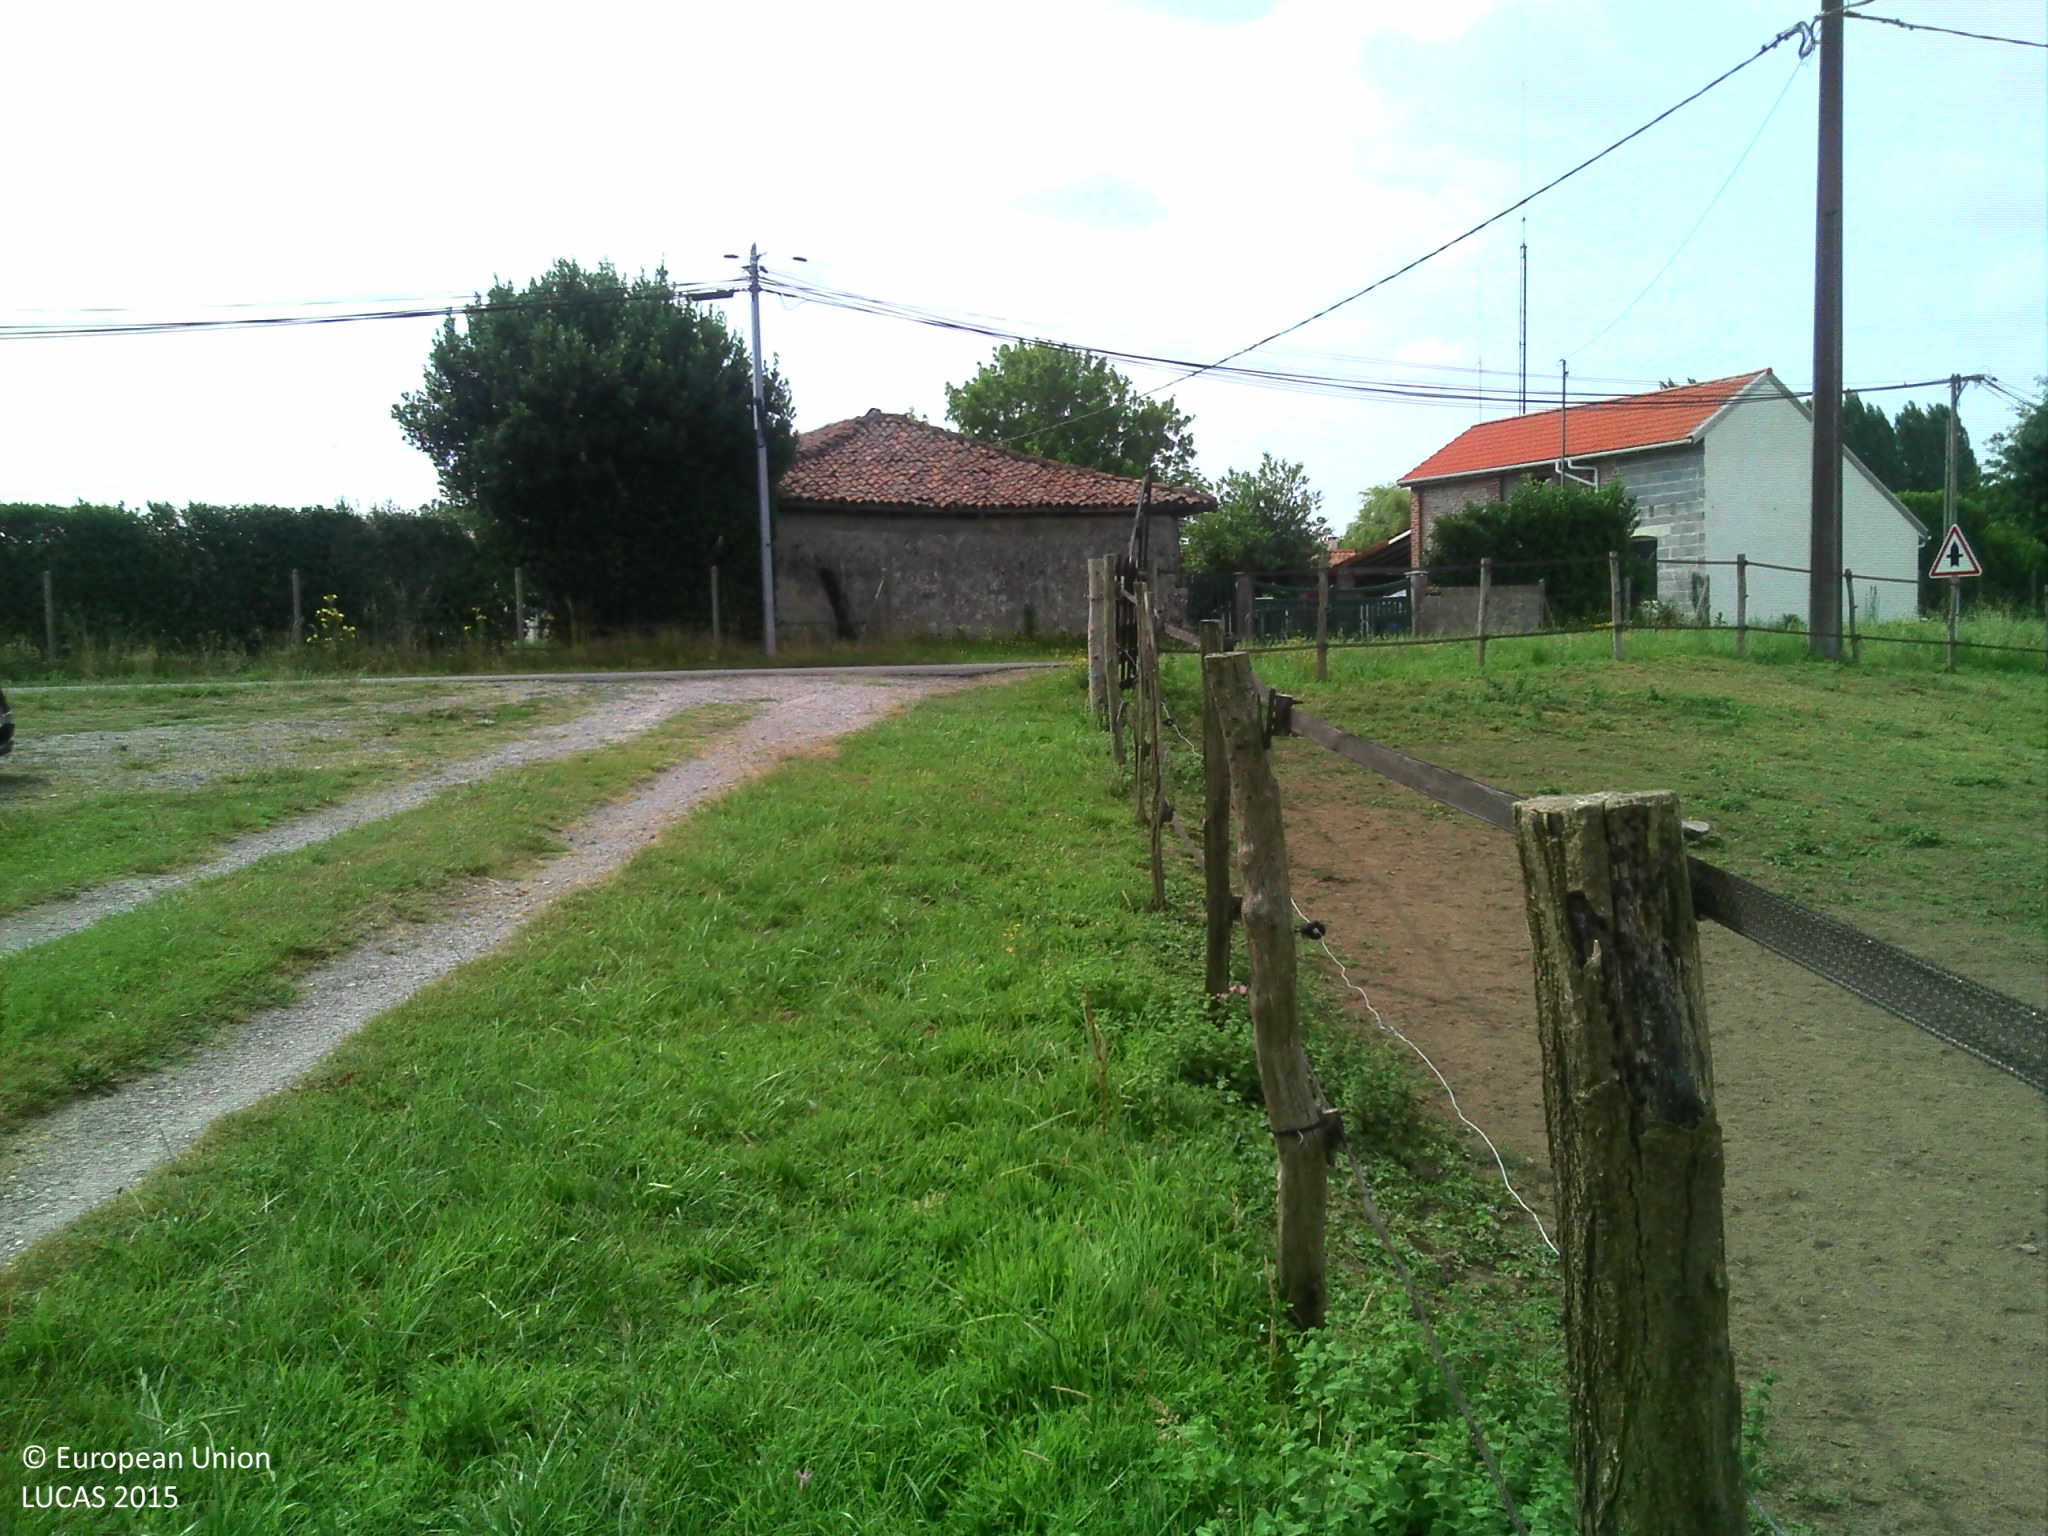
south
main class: Grassland
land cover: Grassland without tree/shrub cover
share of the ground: > 75 %
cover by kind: herbaceous plants 95 %, unconsolidated bare surface 5 %
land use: Agriculture (excluding fallow land and kitchen gardens)
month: July
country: FR
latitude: 43.7665
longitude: -1.3105
